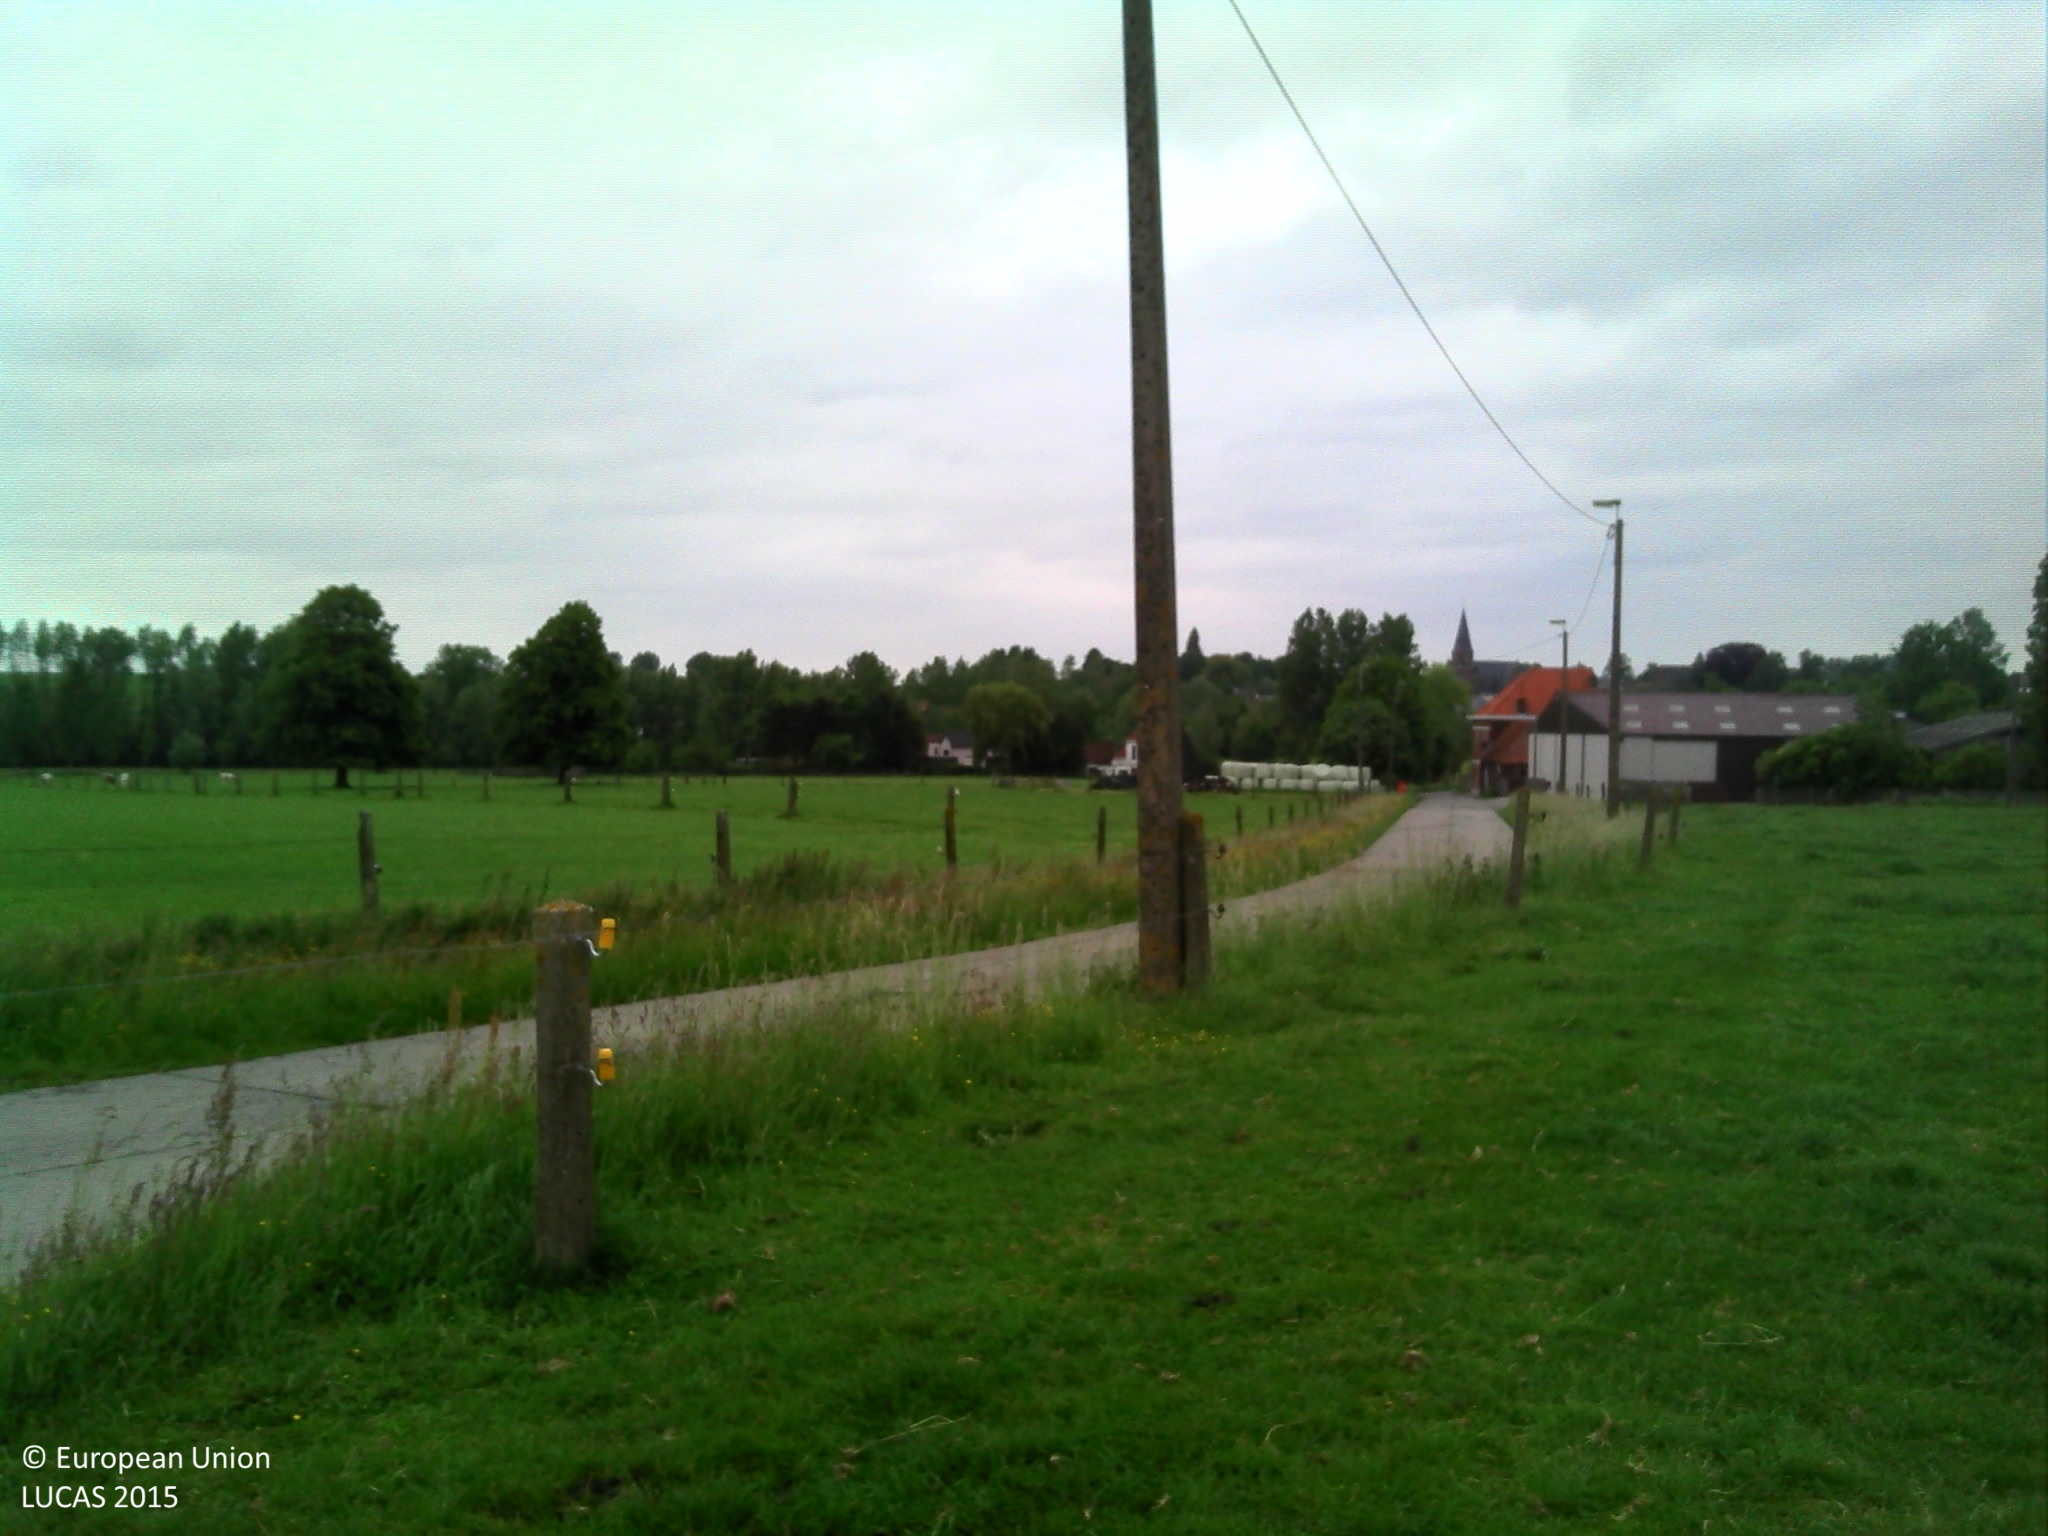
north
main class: Grassland
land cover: Grassland without tree/shrub cover
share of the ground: > 75 %
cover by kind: herbaceous plants 100 %
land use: Agriculture (excluding fallow land and kitchen gardens)
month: June
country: BE
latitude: 50.8623
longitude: 3.7846
